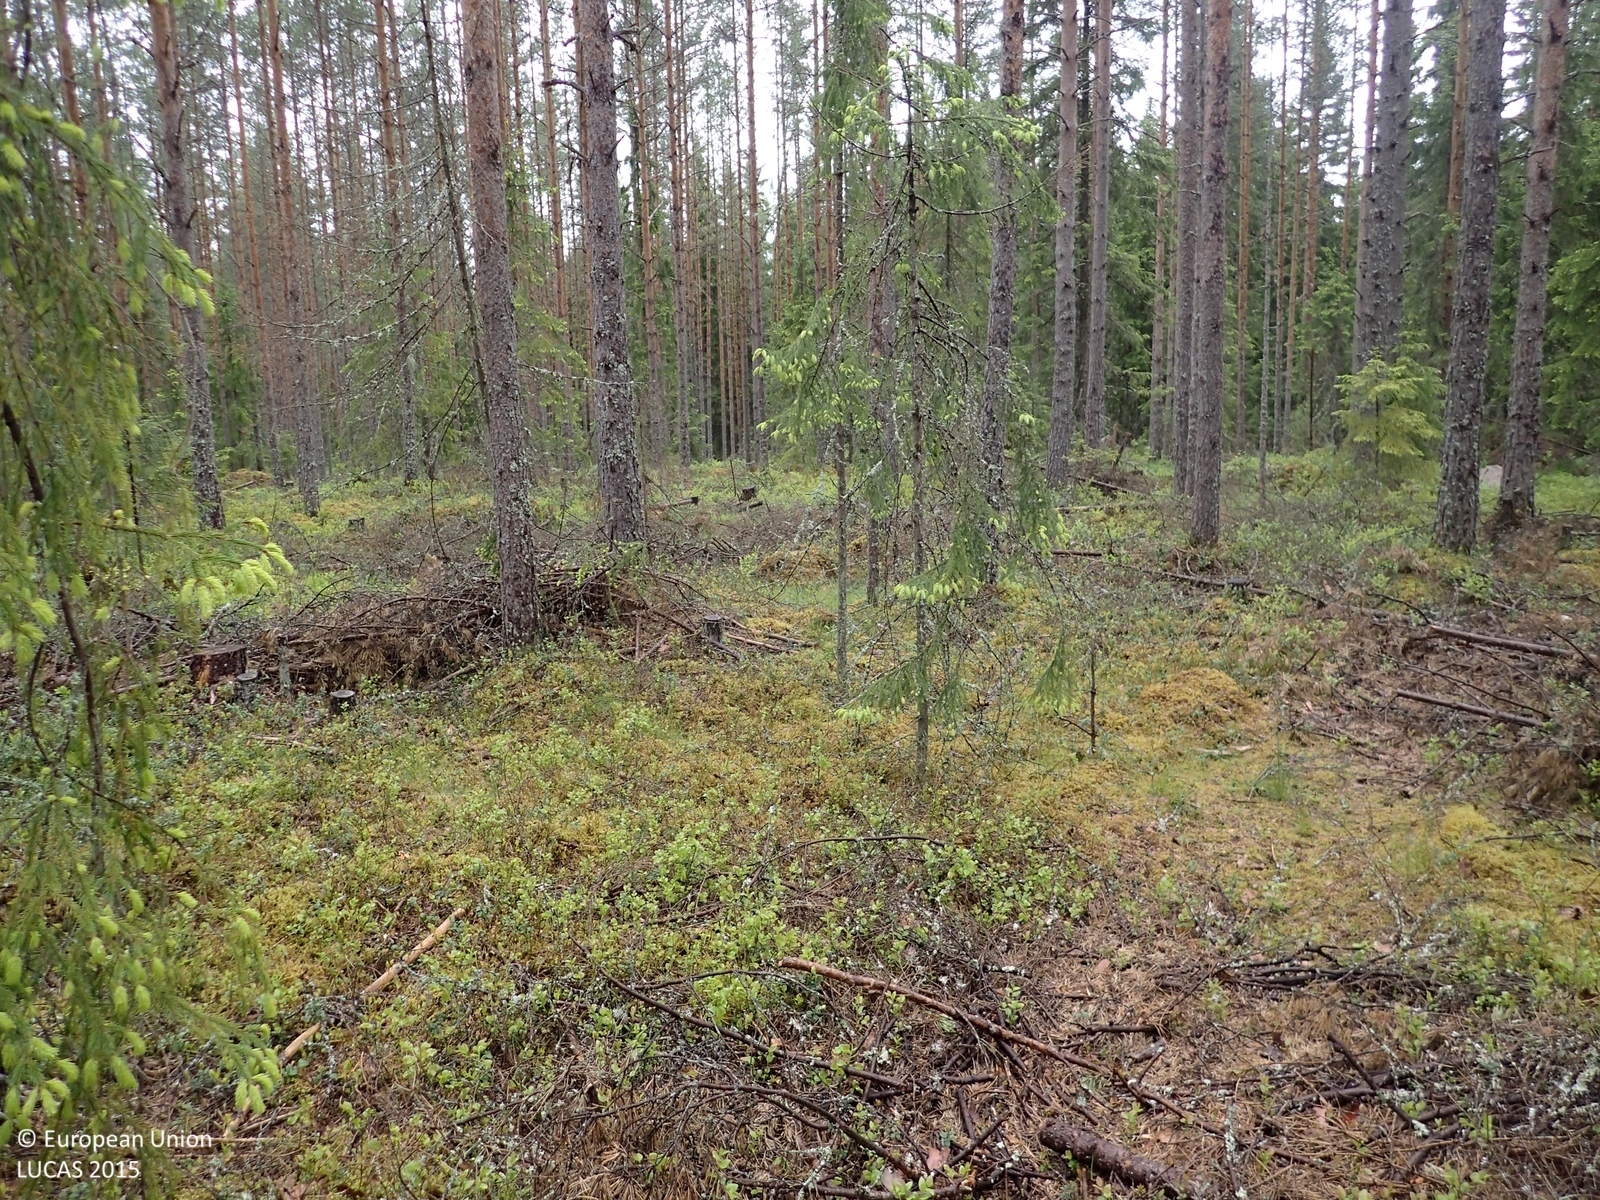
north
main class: Woodland
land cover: Pine dominated coniferous woodland
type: boreal forest
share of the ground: > 75 %
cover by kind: coniferous forest trees 75 %, shrubs 15 %, herbaceous plants 5 %, lichens and mosses 5 %
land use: Forestry
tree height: > 5 m
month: June
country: FI
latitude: 62.2140
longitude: 21.6420
